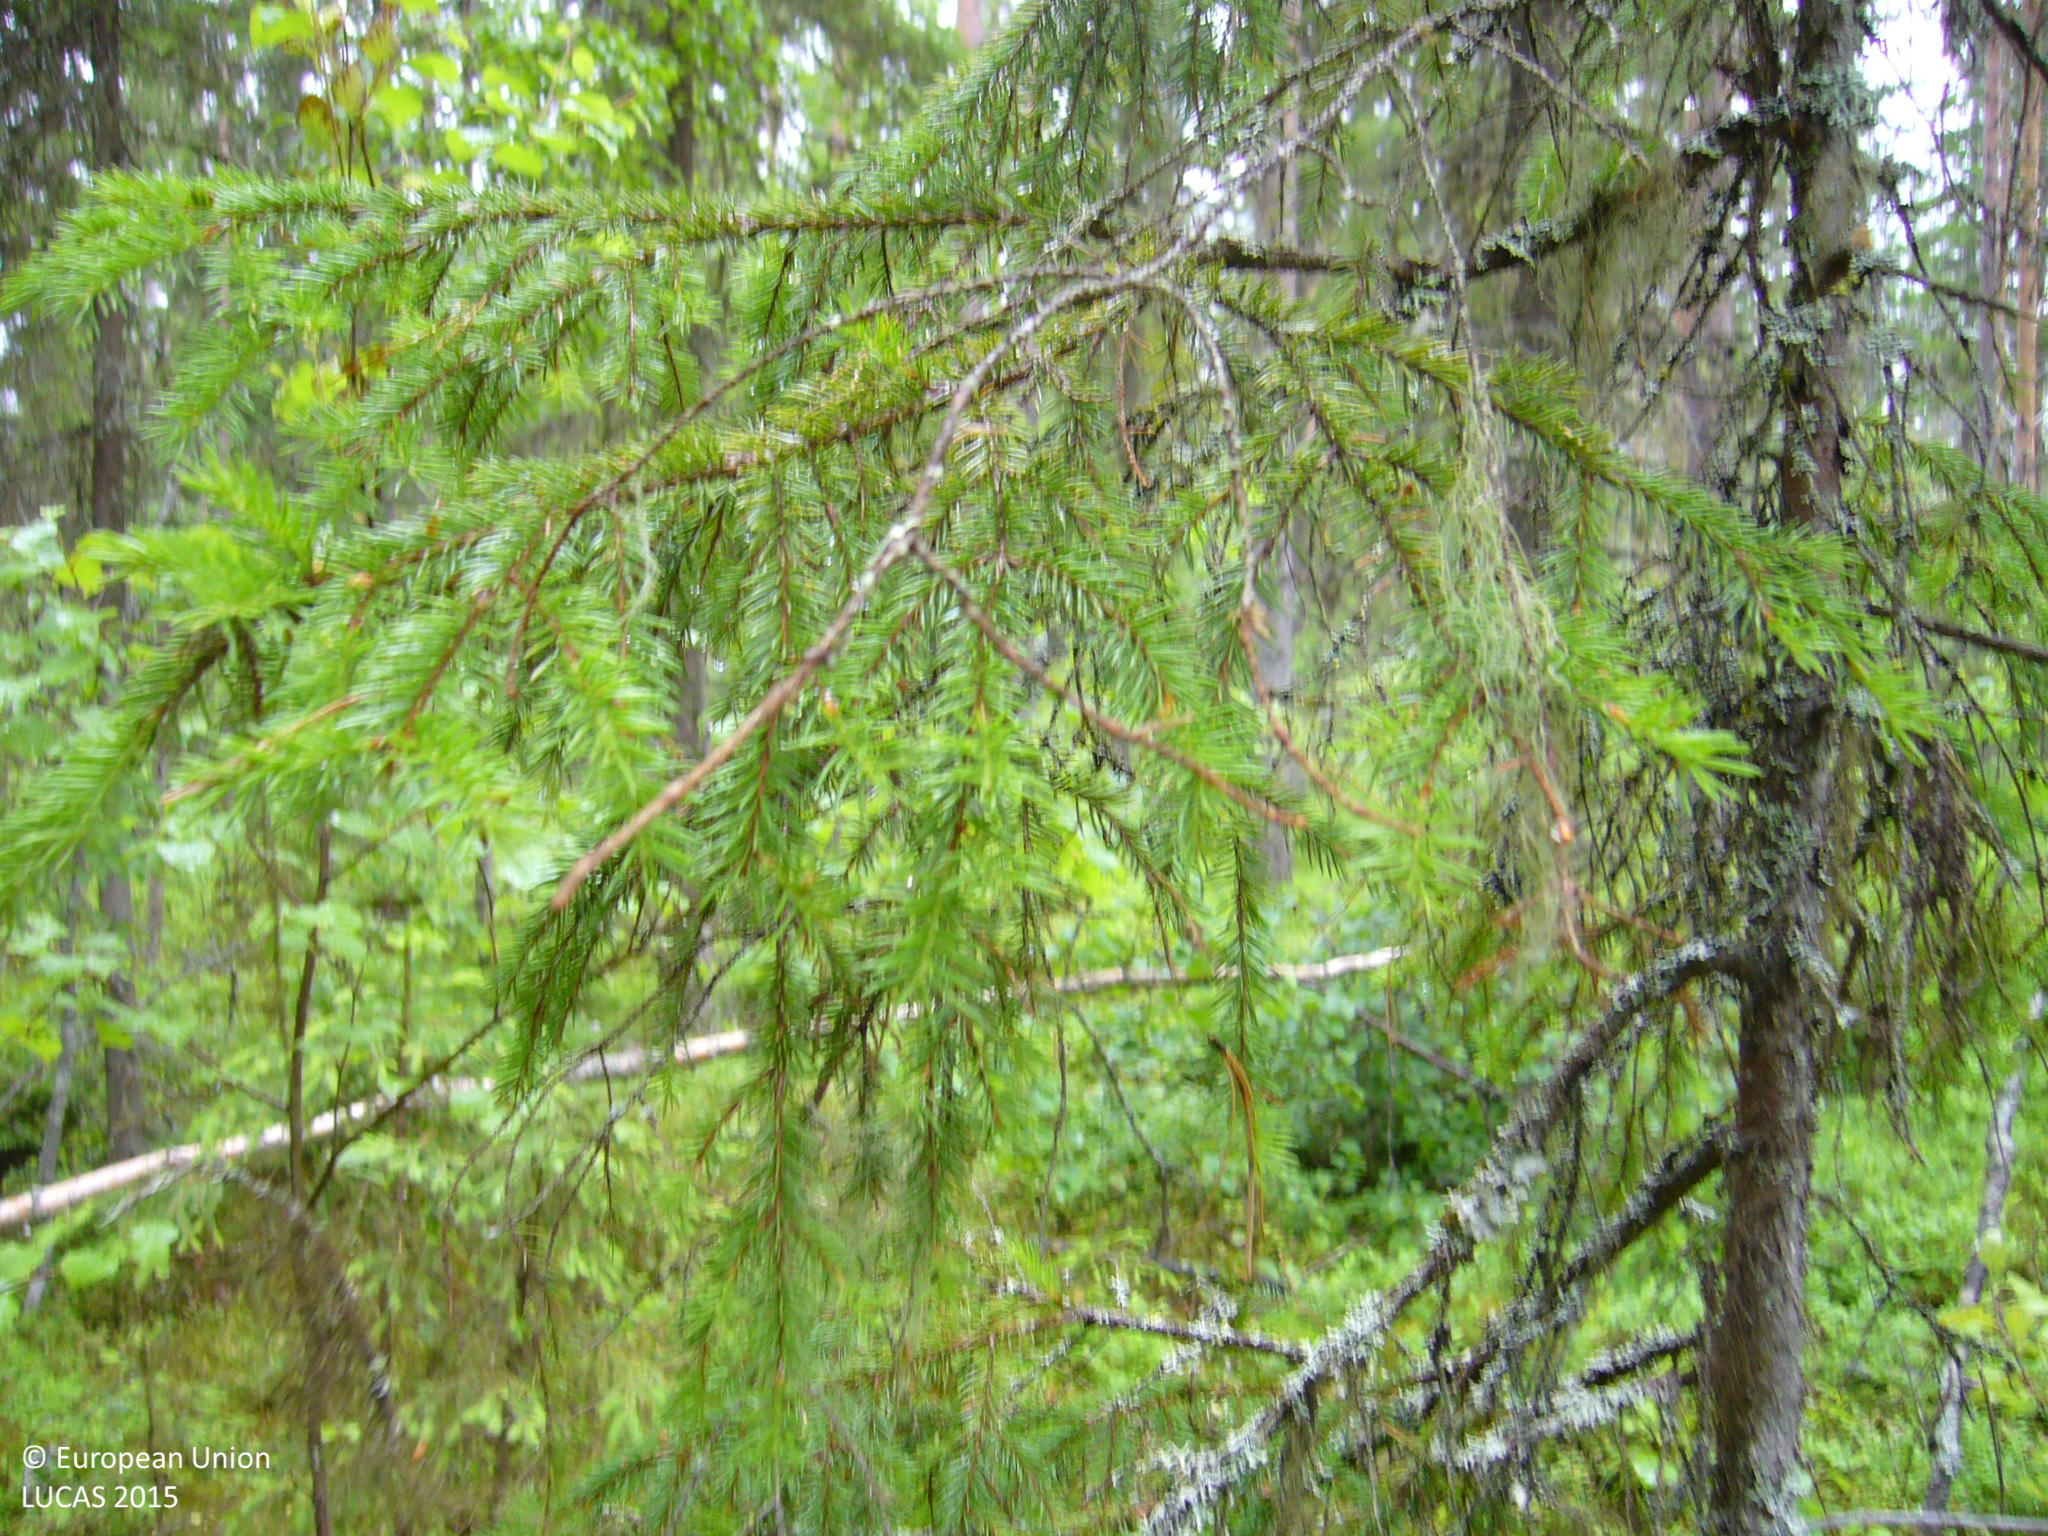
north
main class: Woodland
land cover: Spruce dominated coniferous woodland
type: boreal forest
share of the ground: > 75 %
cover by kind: coniferous forest trees 65 %, shrubs 25 %, broadleaved forest trees 10 %
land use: Forestry
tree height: > 5 m
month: July
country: FI
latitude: 63.4666
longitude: 26.3552
